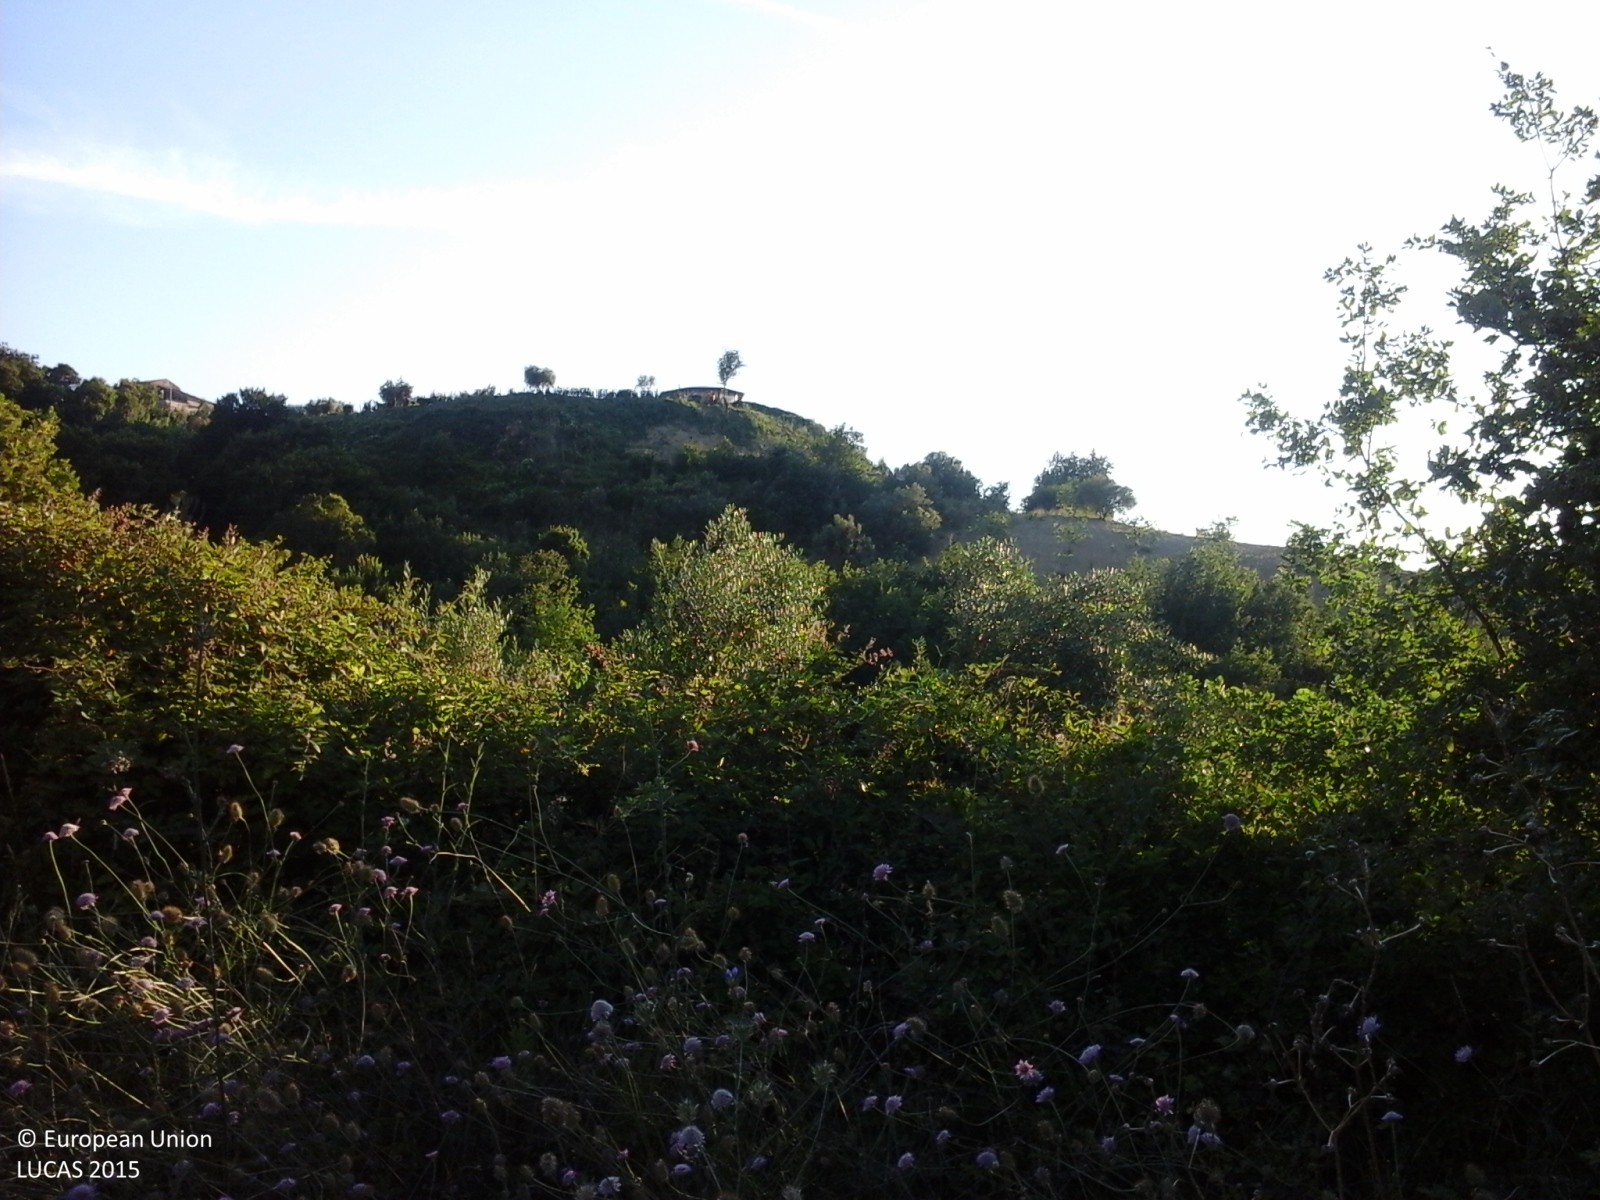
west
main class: Woodland
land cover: Broadleaved woodland
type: thermophilous deciduous forest
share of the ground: > 75 %
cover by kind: broadleaved forest trees 100 %
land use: Forestry
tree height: > 5 m
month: June
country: IT
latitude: 40.3739
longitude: 15.0307
